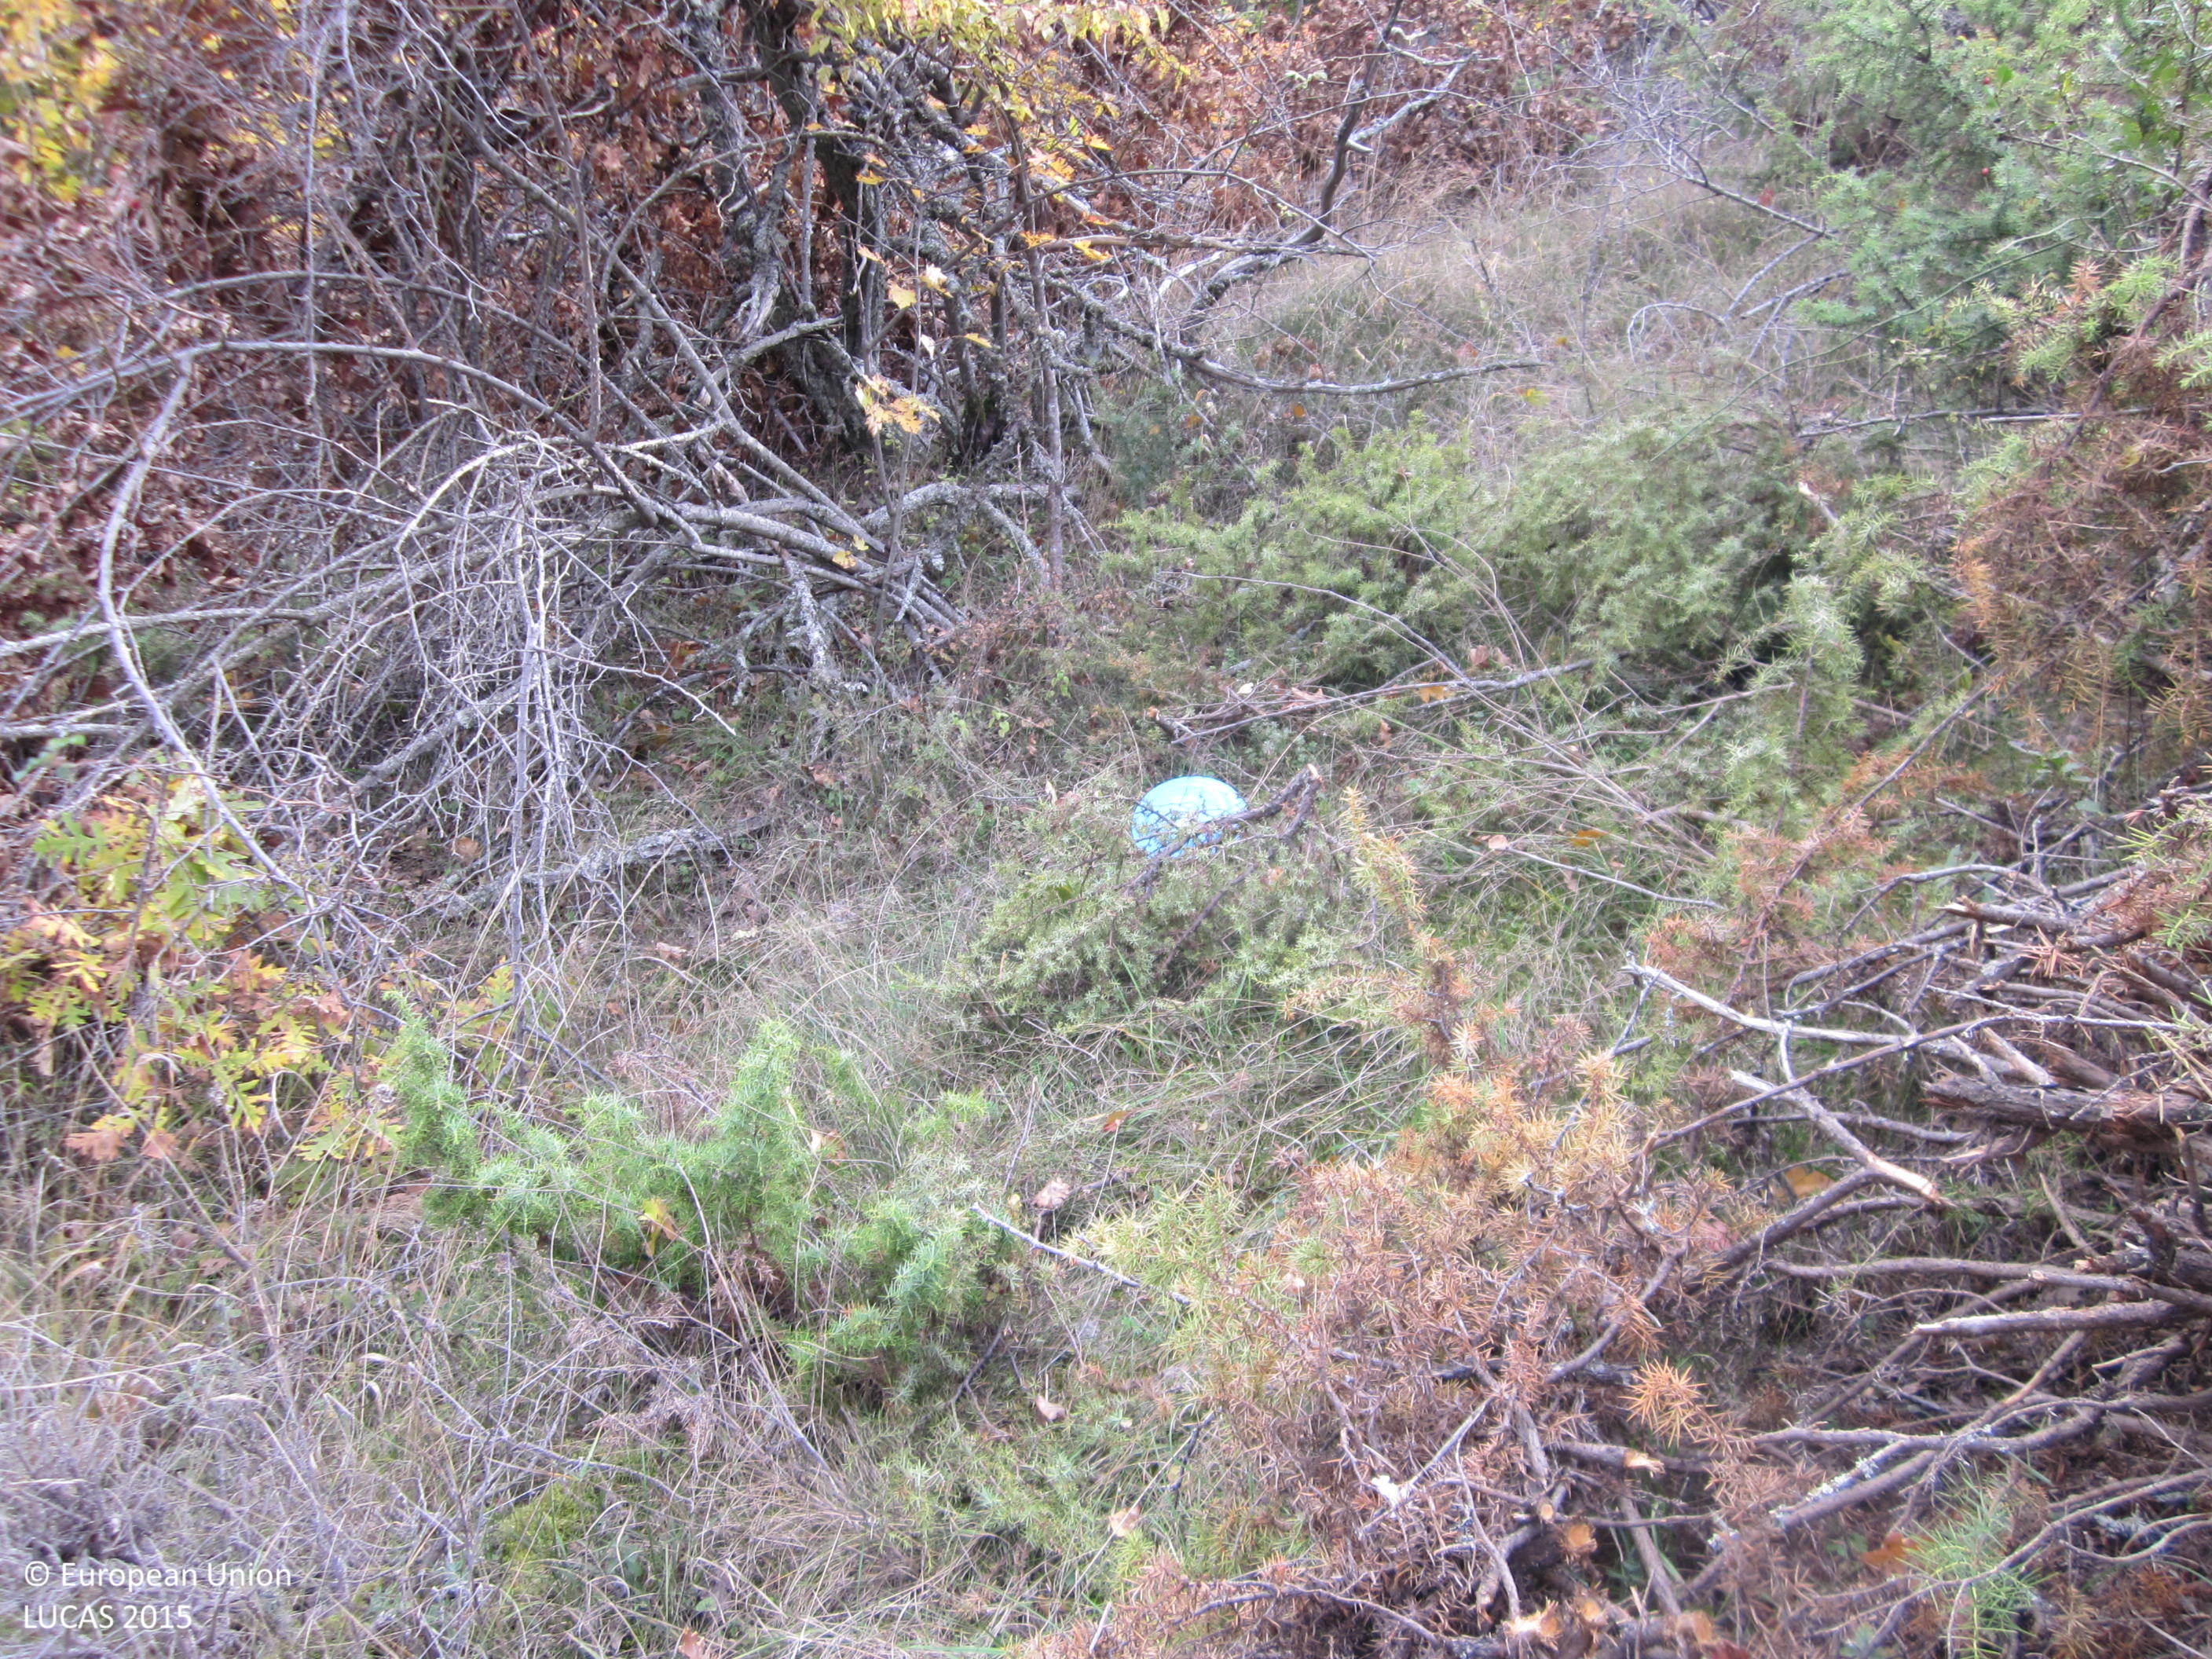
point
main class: Woodland
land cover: Broadleaved woodland
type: mesophytic deciduous forest
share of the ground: 50 - 75 %
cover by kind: broadleaved forest trees 50 %, herbaceous plants 25 %, shrubs 20 %, coniferous forest trees 5 %
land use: Forestry
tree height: > 5 m
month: November
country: BG
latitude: 41.3770
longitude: 25.8581
